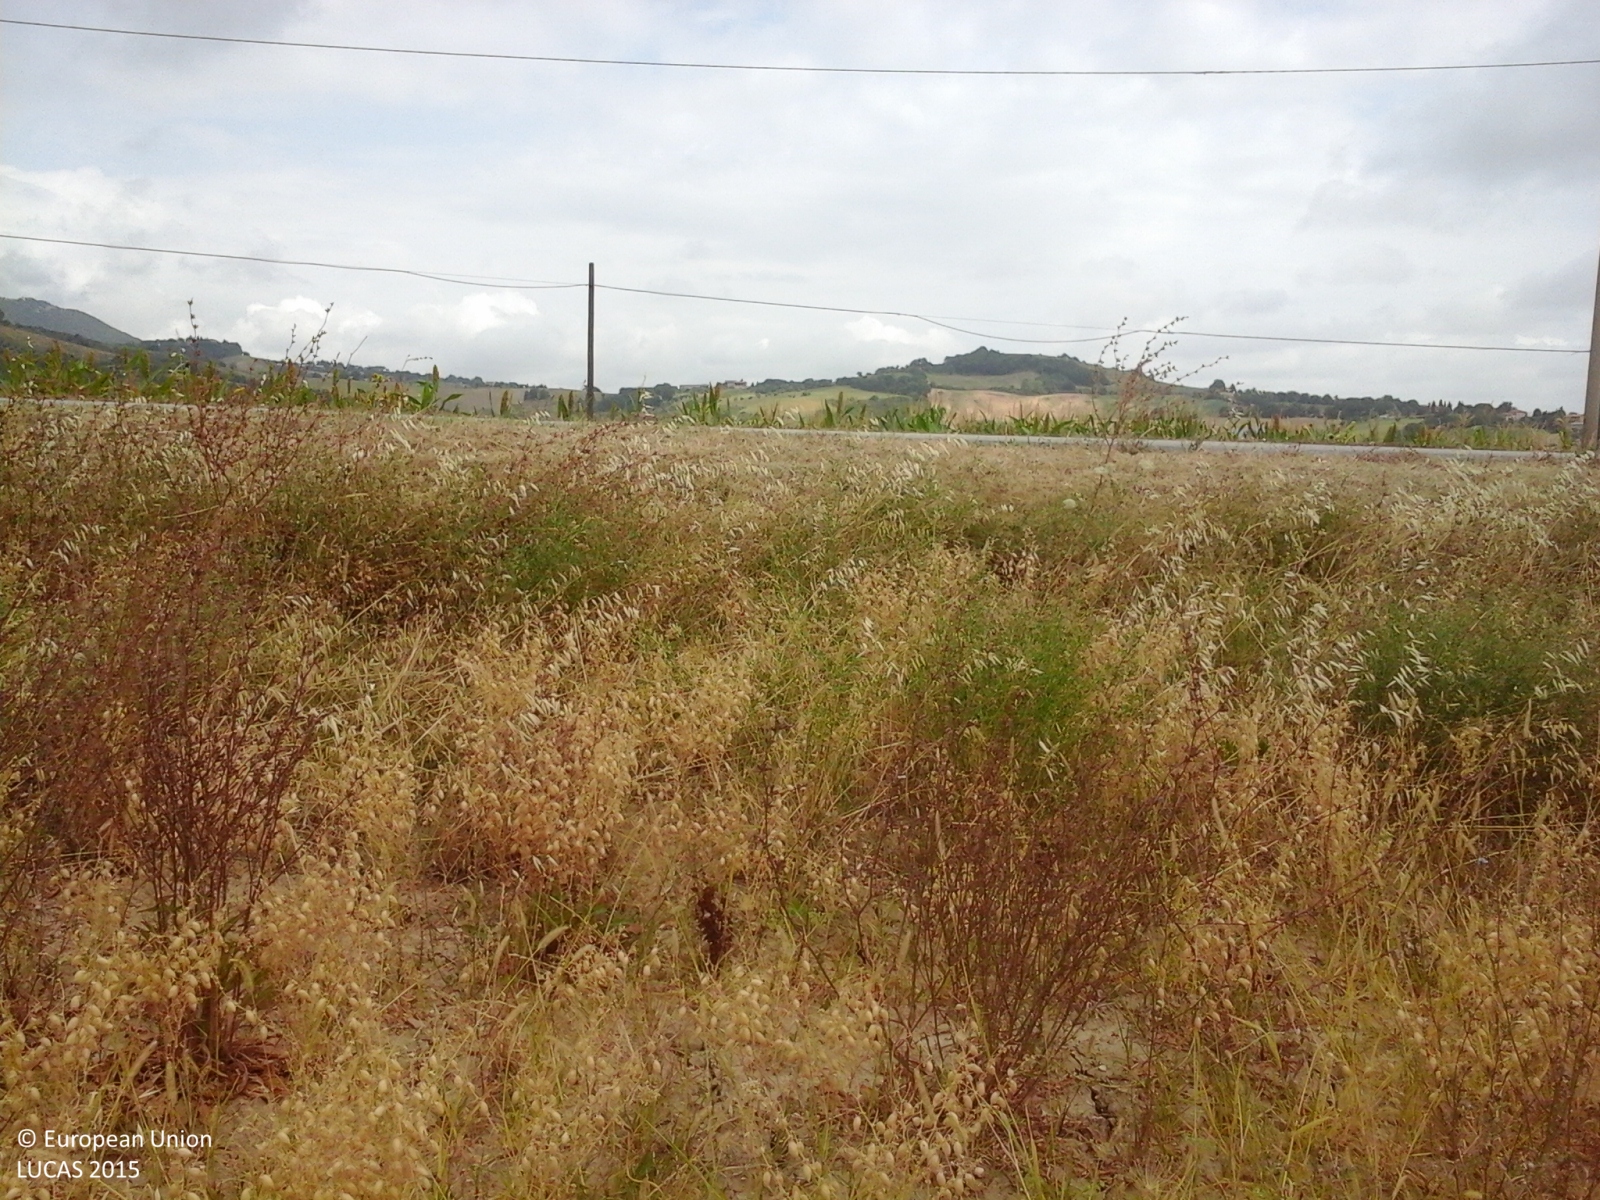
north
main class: Cropland
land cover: Dry pulses
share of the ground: > 75 %
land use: Agriculture (excluding fallow land and kitchen gardens)
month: July
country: IT
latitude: 43.2883
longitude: 13.2575
